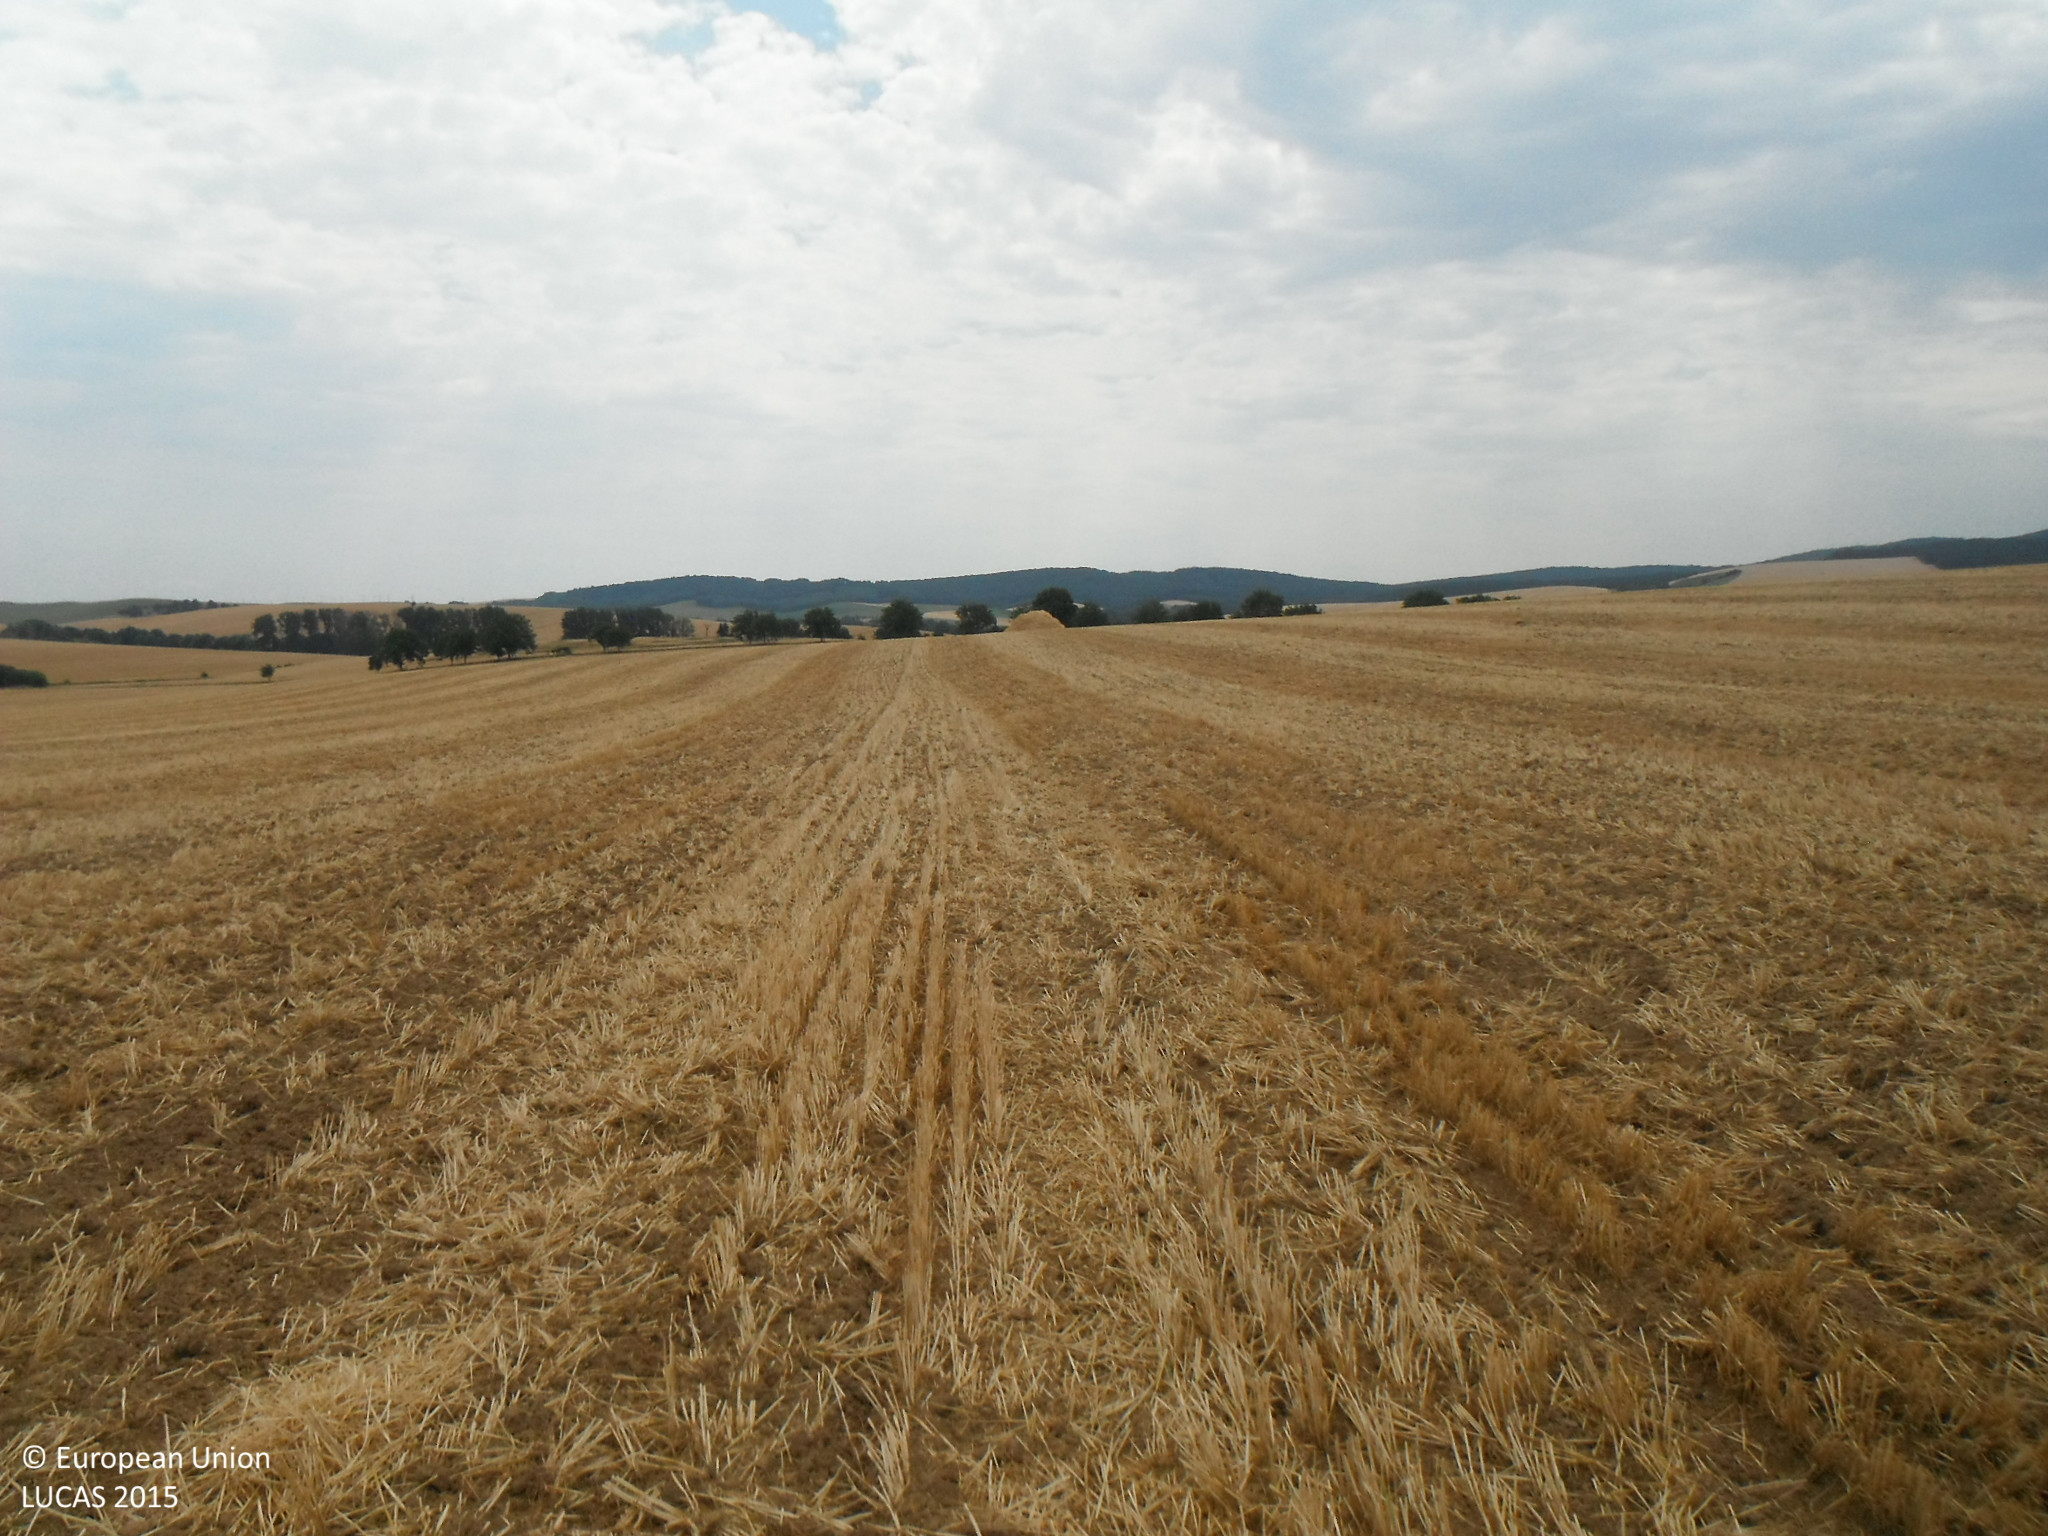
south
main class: Cropland
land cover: Barley
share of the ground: 25 - 50 %
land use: Agriculture (excluding fallow land and kitchen gardens)
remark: Harvested field
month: July
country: SK
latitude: 48.7769
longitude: 17.2903
